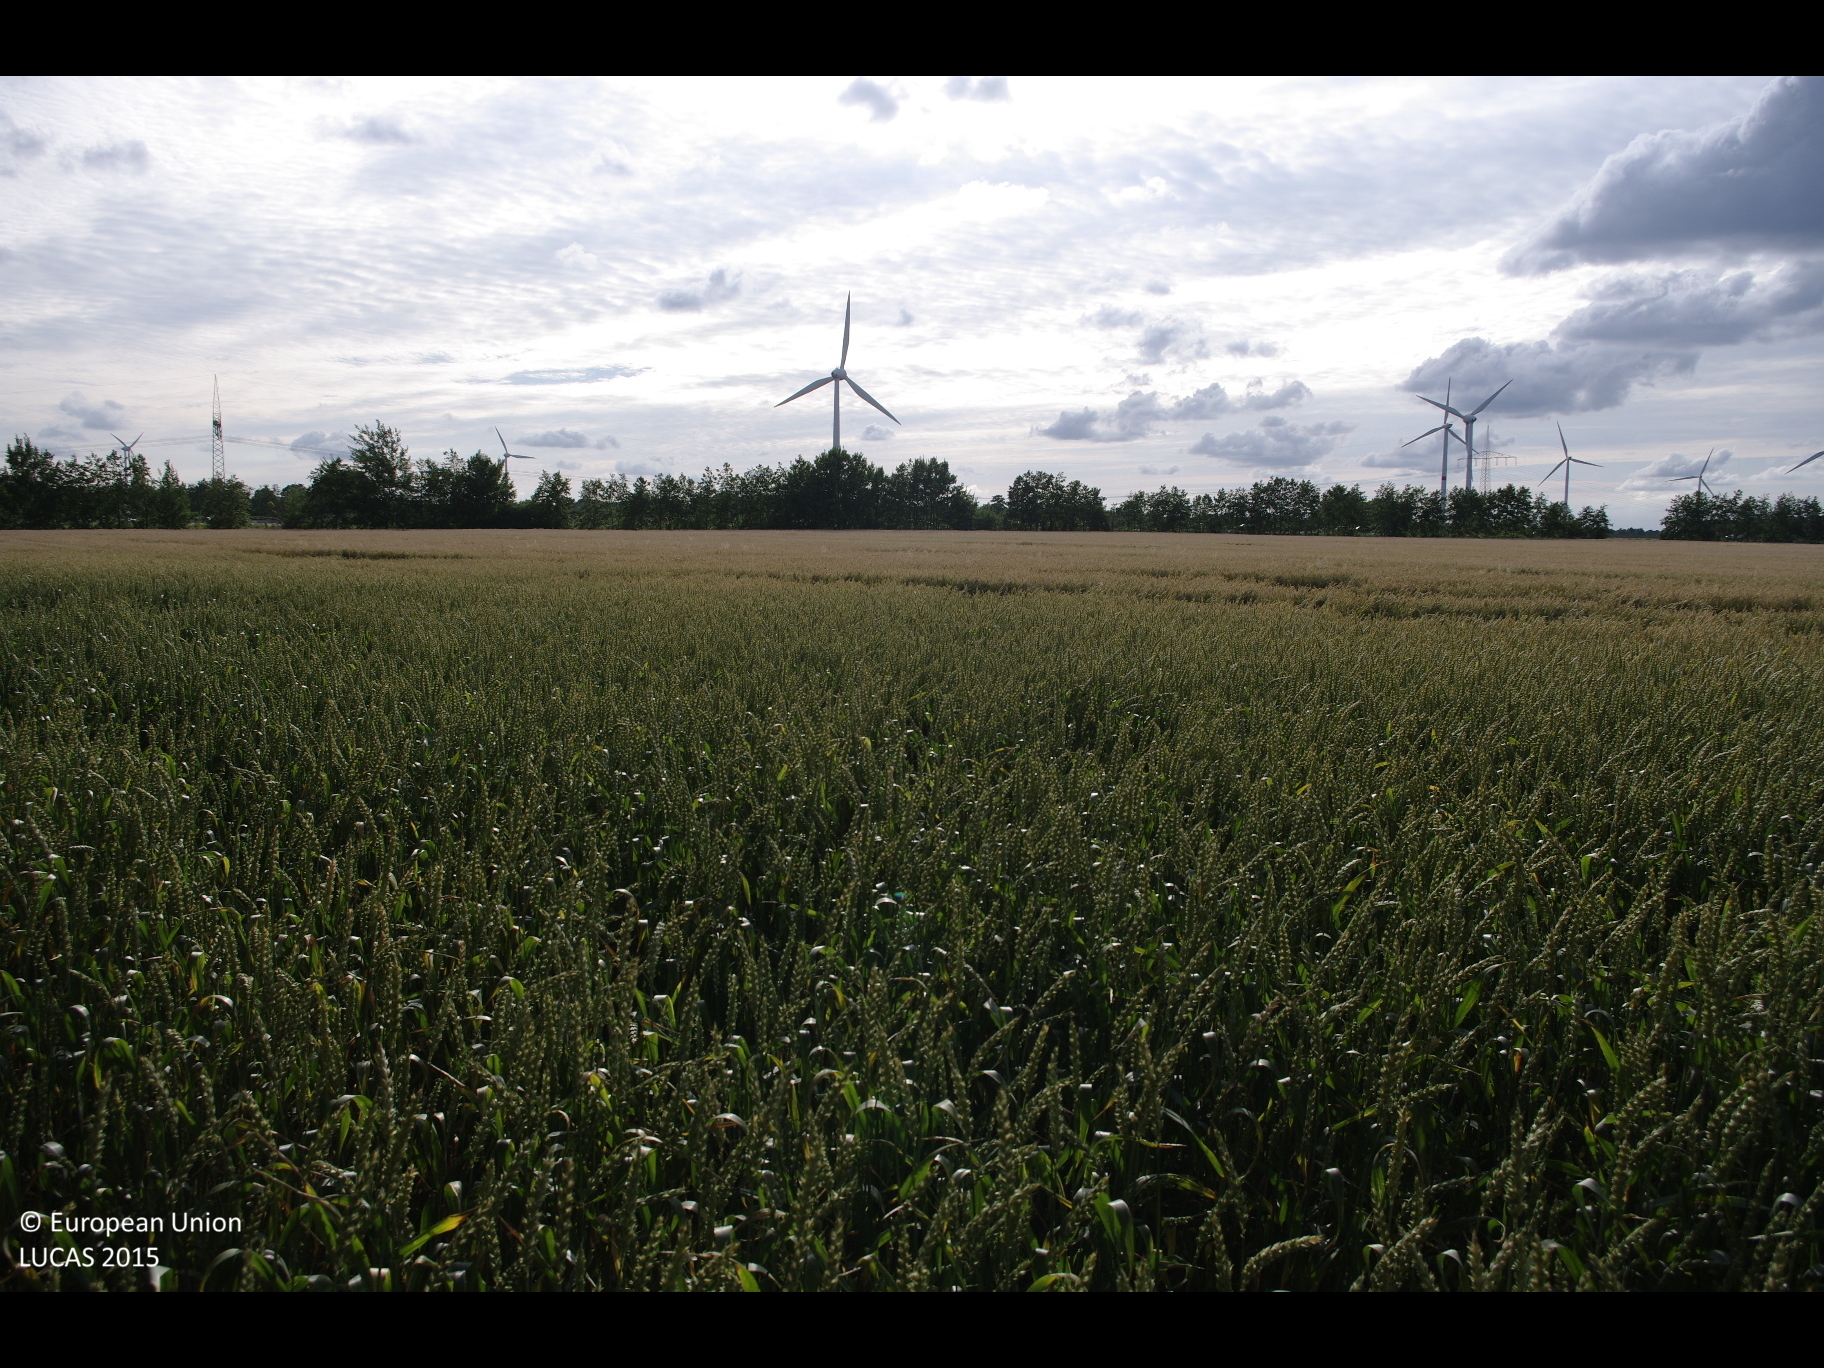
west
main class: Cropland
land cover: Common wheat
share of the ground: > 75 %
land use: Agriculture (excluding fallow land and kitchen gardens)
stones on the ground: < 10 %
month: July
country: DE
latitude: 53.9590
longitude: 9.9543
